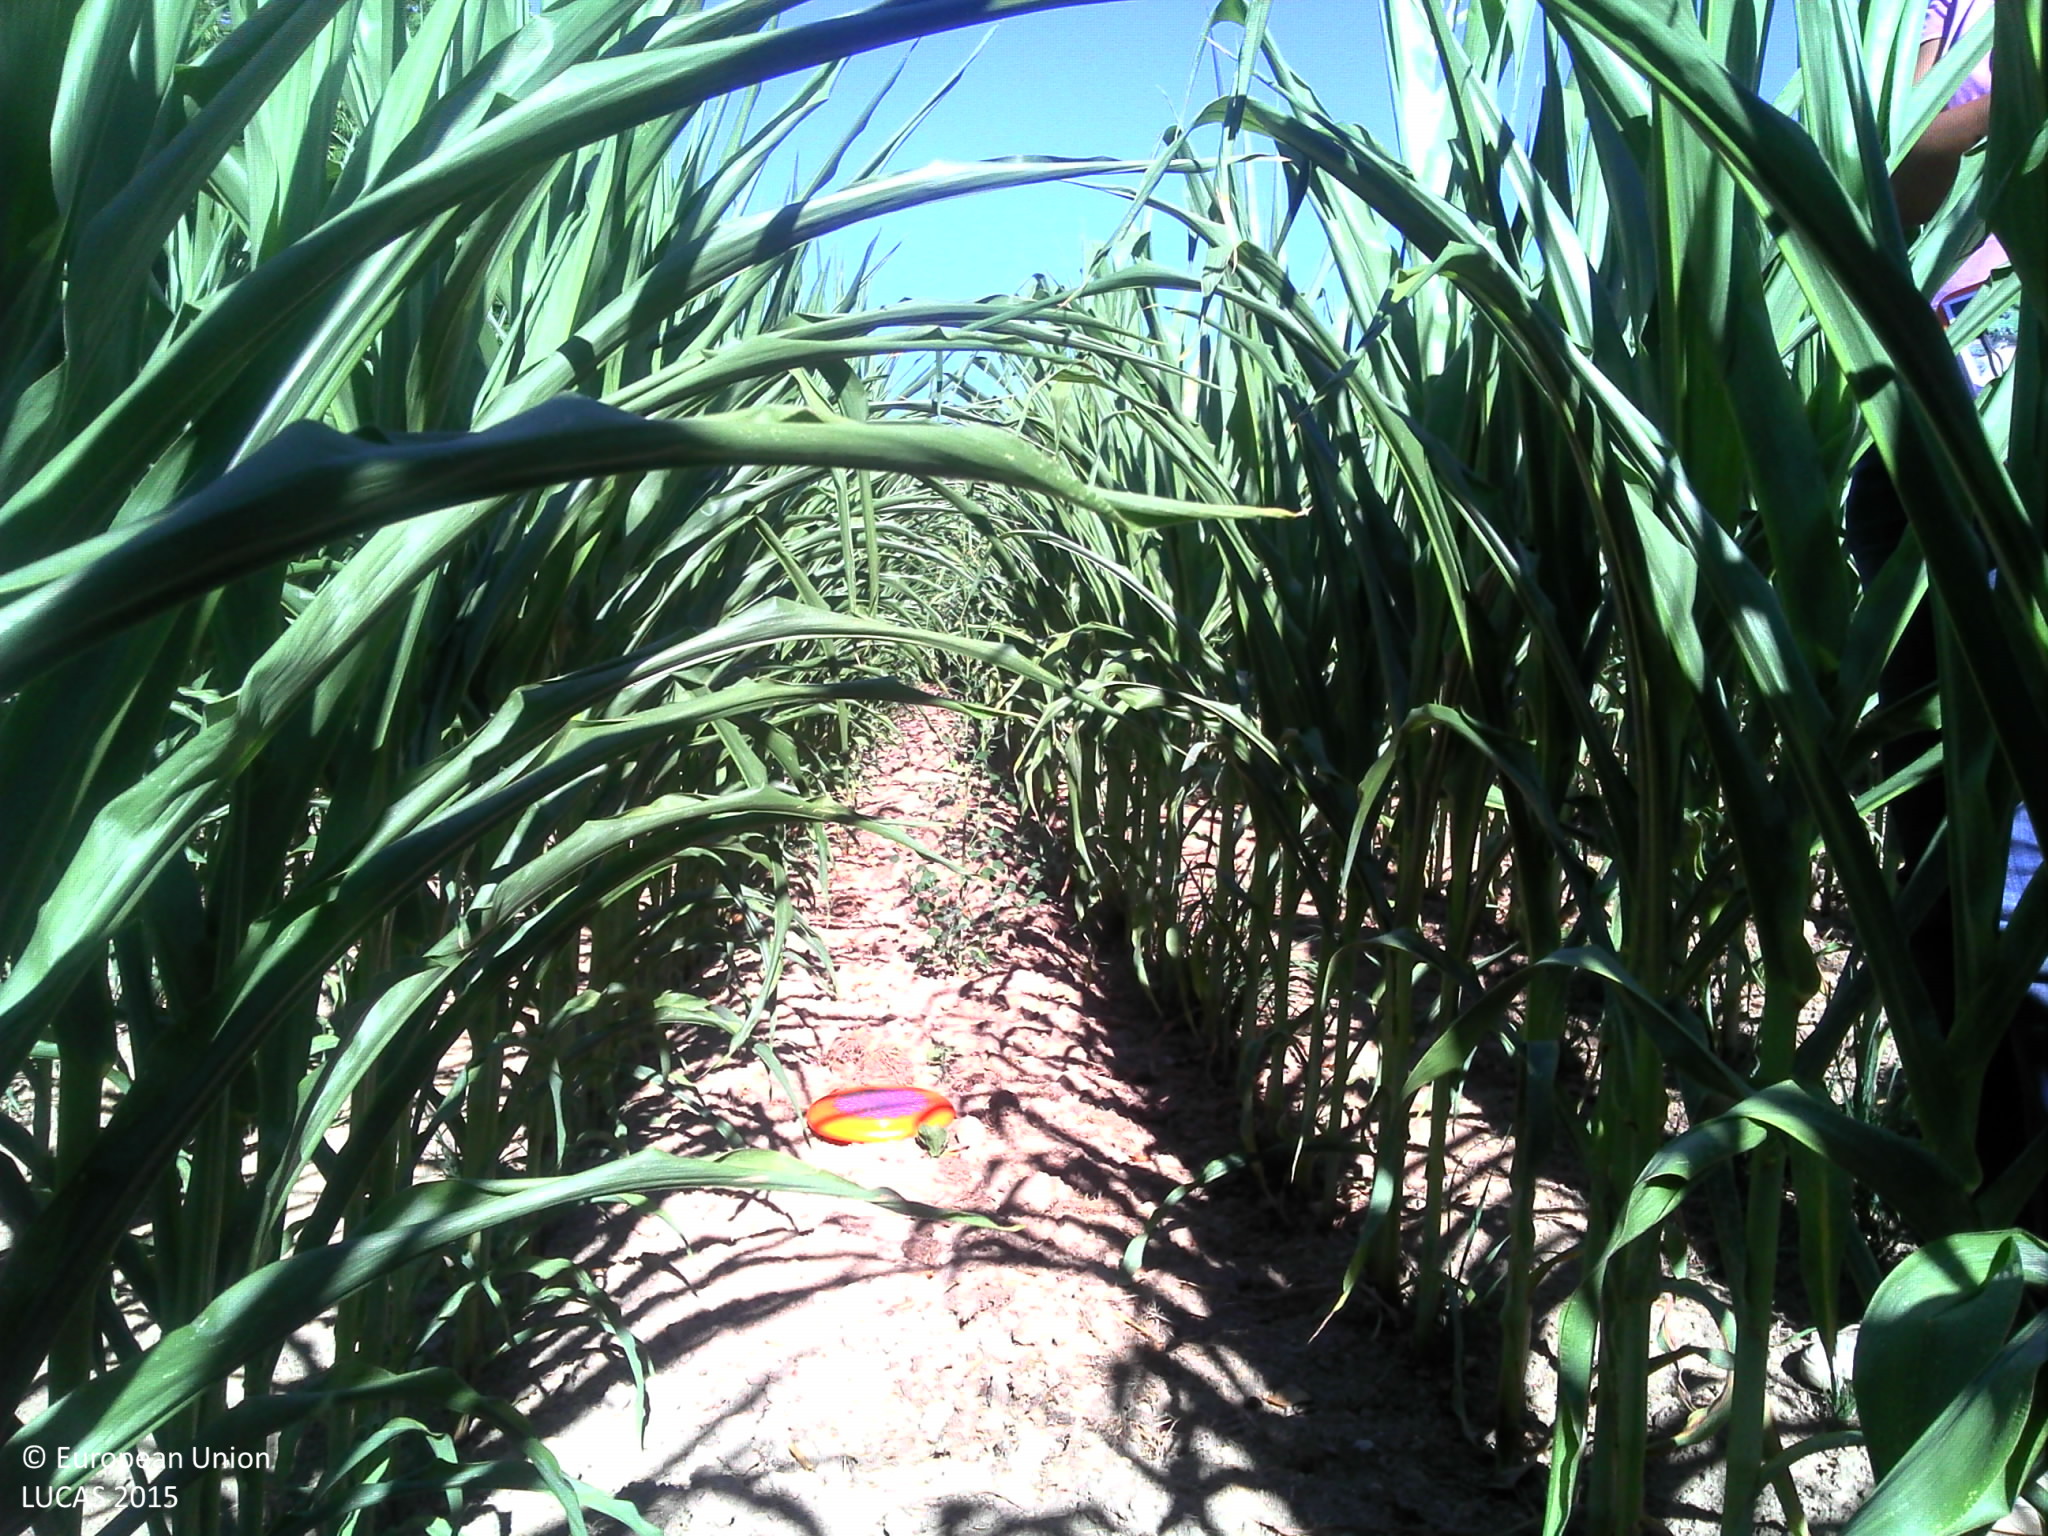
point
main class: Cropland
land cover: Maize
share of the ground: 25 - 50 %
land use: Agriculture (excluding fallow land and kitchen gardens)
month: July
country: FR
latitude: 45.5798
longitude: 1.7542
